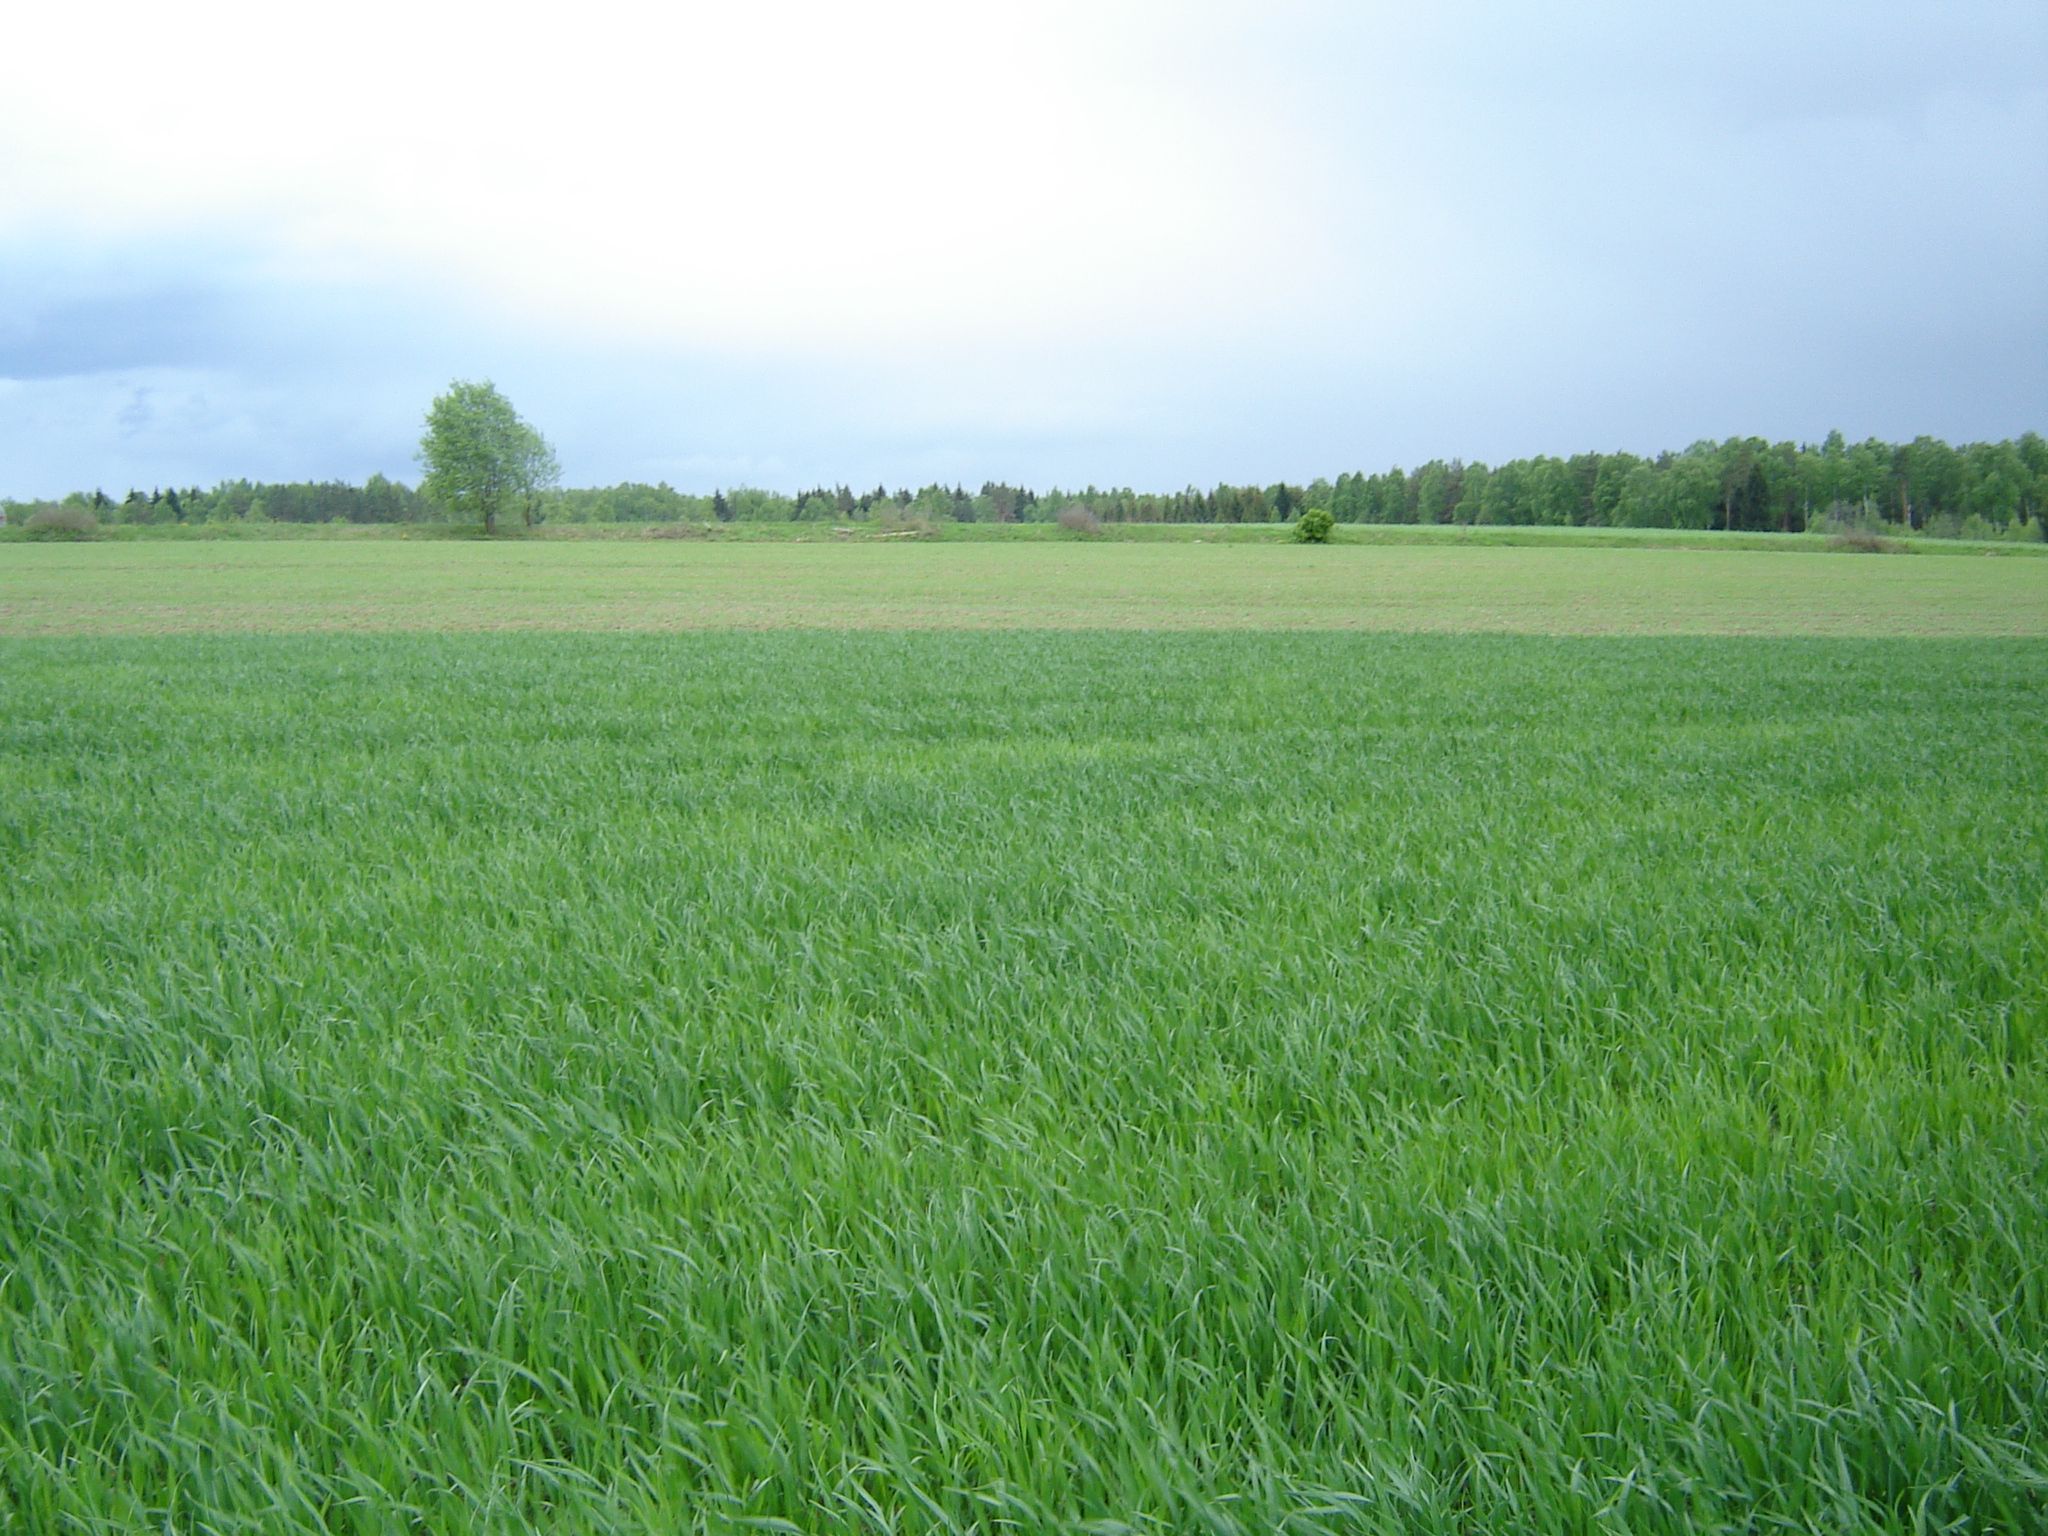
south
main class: Cropland
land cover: Barley
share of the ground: > 75 %
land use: Agriculture (excluding fallow land and kitchen gardens)
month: May
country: LT
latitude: 56.1320
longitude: 25.3880
